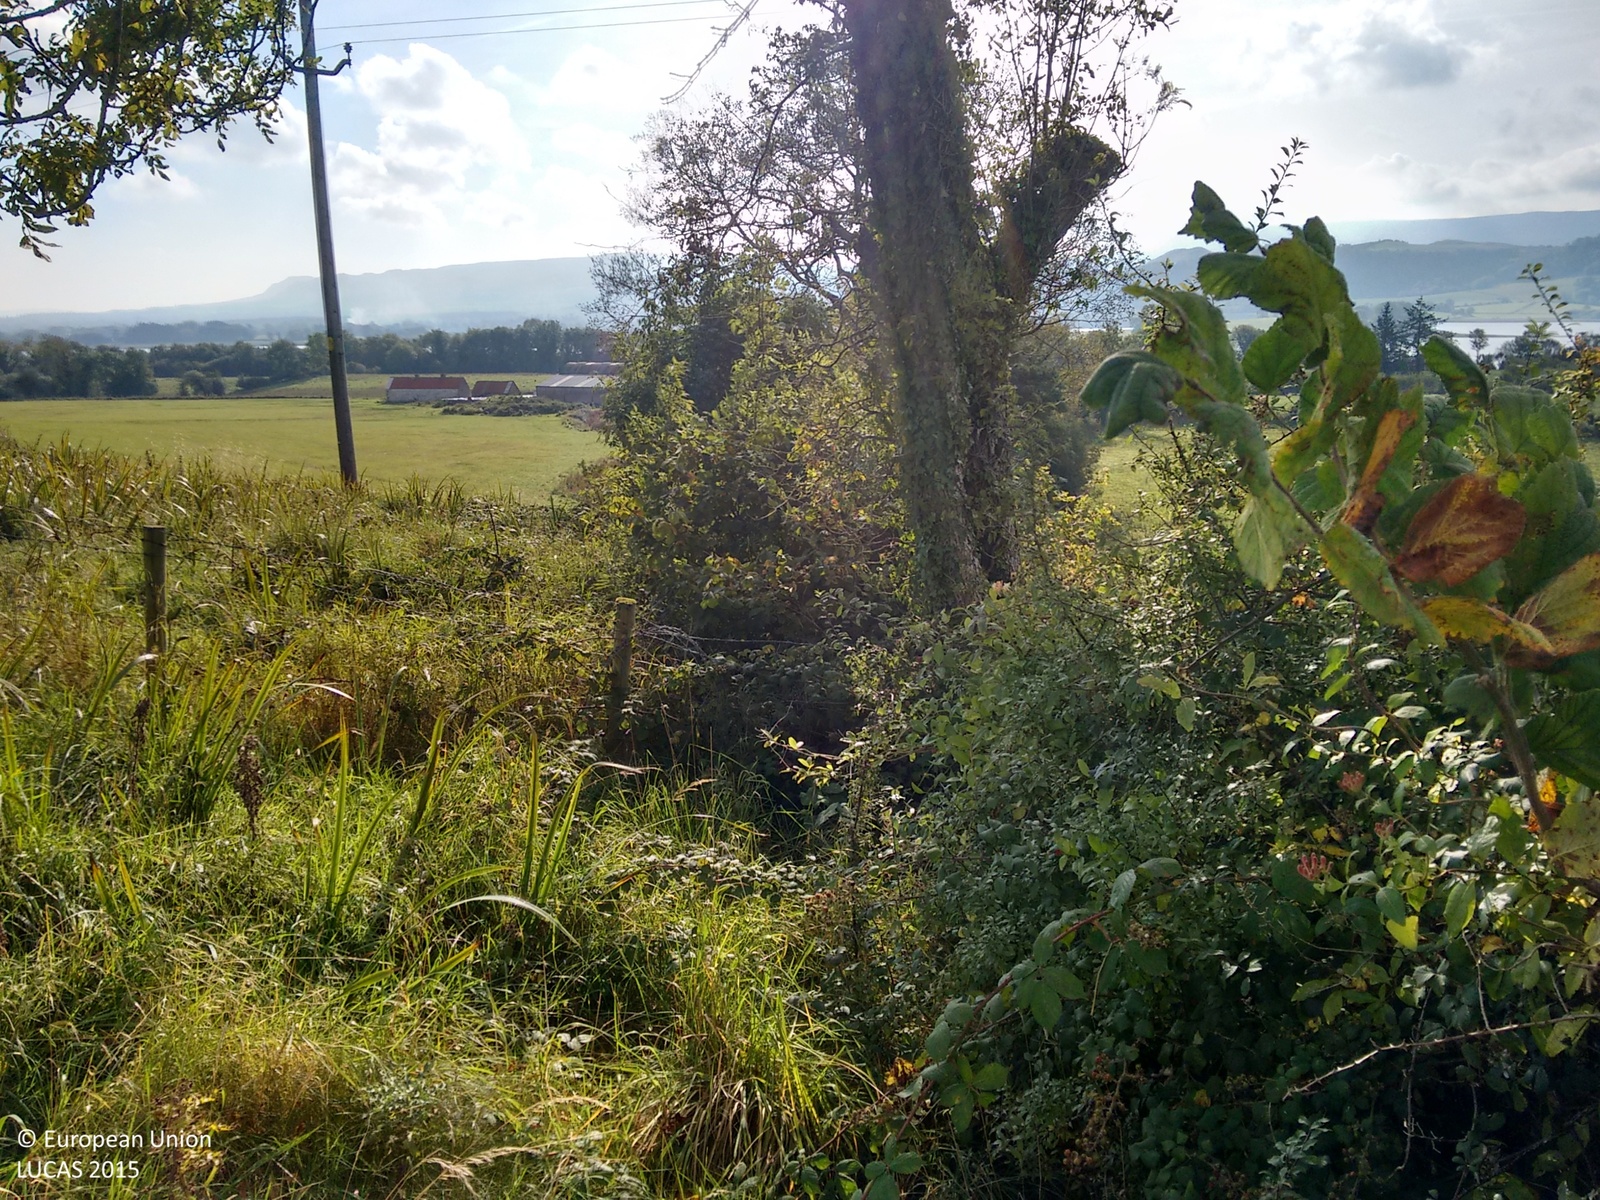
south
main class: Grassland
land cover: Grassland without tree/shrub cover
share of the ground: > 75 %
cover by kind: herbaceous plants 100 %
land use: Agriculture (excluding fallow land and kitchen gardens)
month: October
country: GB
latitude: 54.2963
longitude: -7.8217
